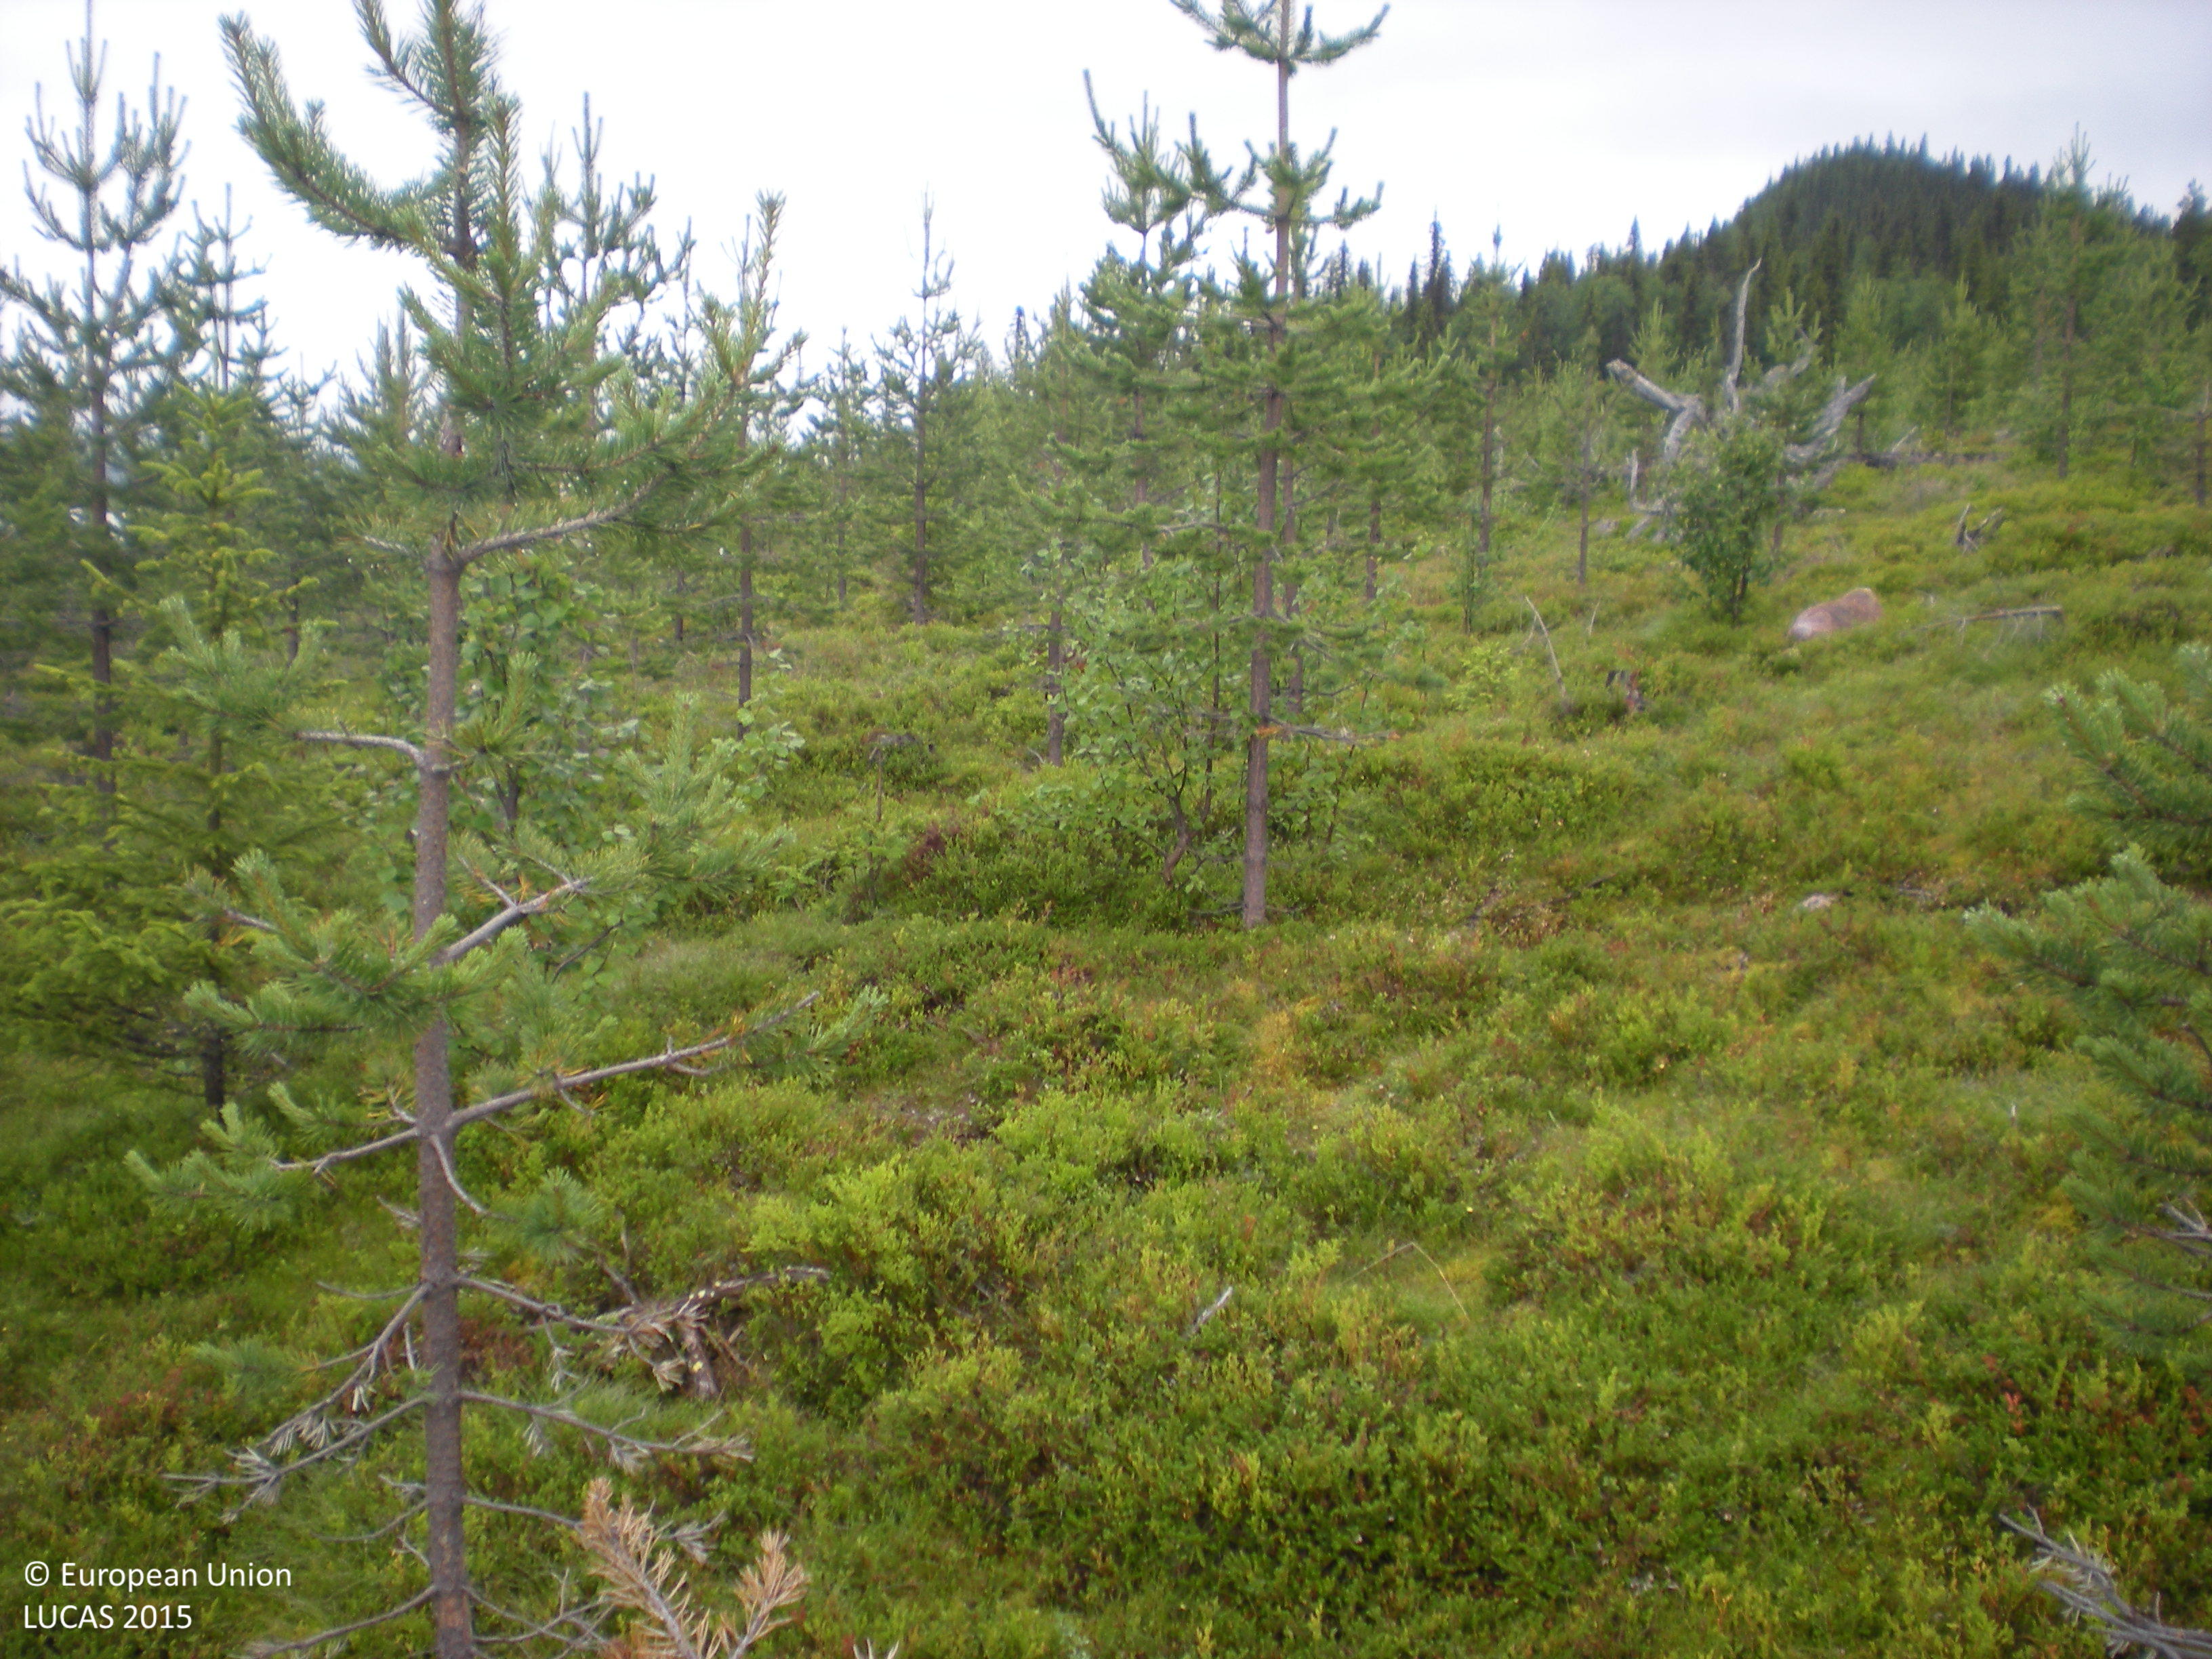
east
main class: Woodland
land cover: Pine dominated mixed woodland
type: boreal forest
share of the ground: 25 - 50 %
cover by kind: coniferous forest trees 35 %, shrubs 30 %, broadleaved forest trees 15 %, lichens and mosses 15 %, herbaceous plants 5 %
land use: Forestry
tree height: < 5 m
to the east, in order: Pine dominated mixed woodland; Shrubland with sparse tree cover
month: August
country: SE
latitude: 66.0867
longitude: 18.3781
